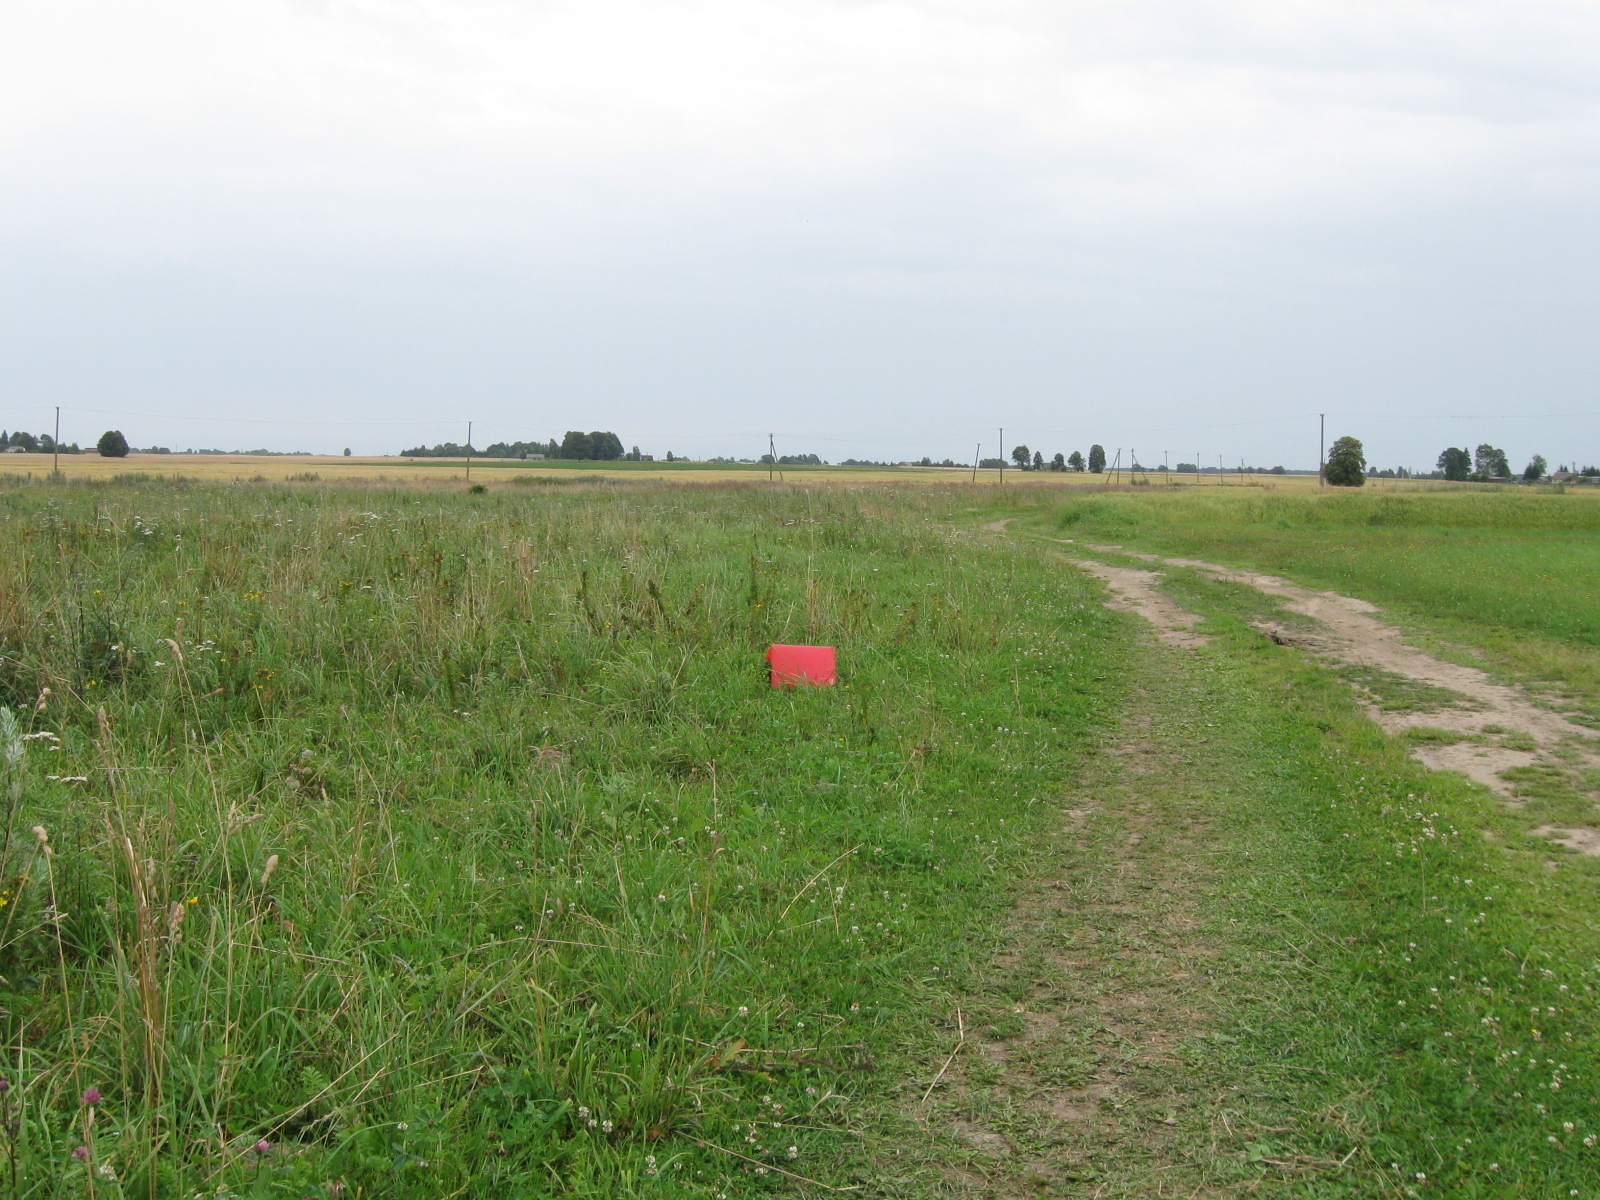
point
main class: Grassland
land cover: Grassland without tree/shrub cover
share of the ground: > 75 %
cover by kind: herbaceous plants 100 %
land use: Agriculture (excluding fallow land and kitchen gardens)
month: July
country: LT
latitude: 54.8618
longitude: 23.7173
